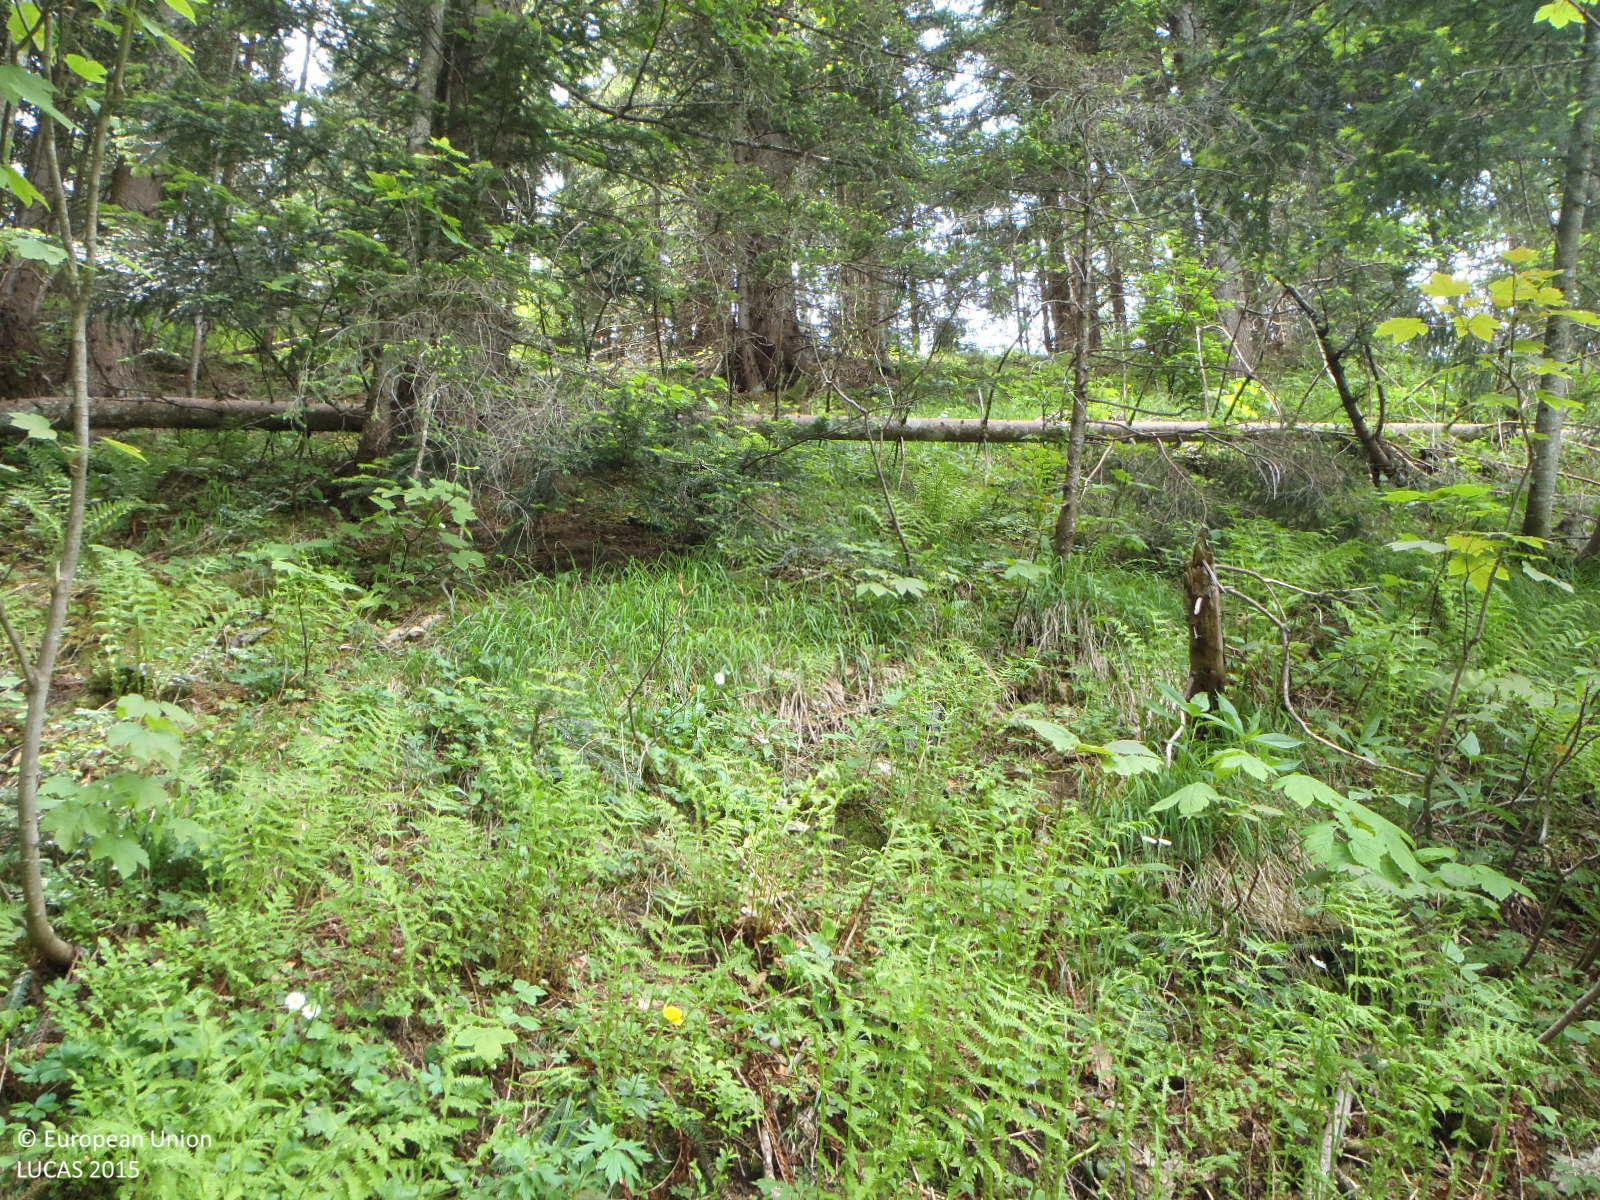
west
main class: Woodland
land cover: Broadleaved woodland
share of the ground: > 75 %
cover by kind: broadleaved forest trees 60 %, coniferous forest trees 10 %, shrubs 10 %, herbaceous plants 10 %, lichens and mosses 10 %
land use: Forestry
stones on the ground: < 10 %
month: June
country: AT
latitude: 47.4909
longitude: 12.5865
